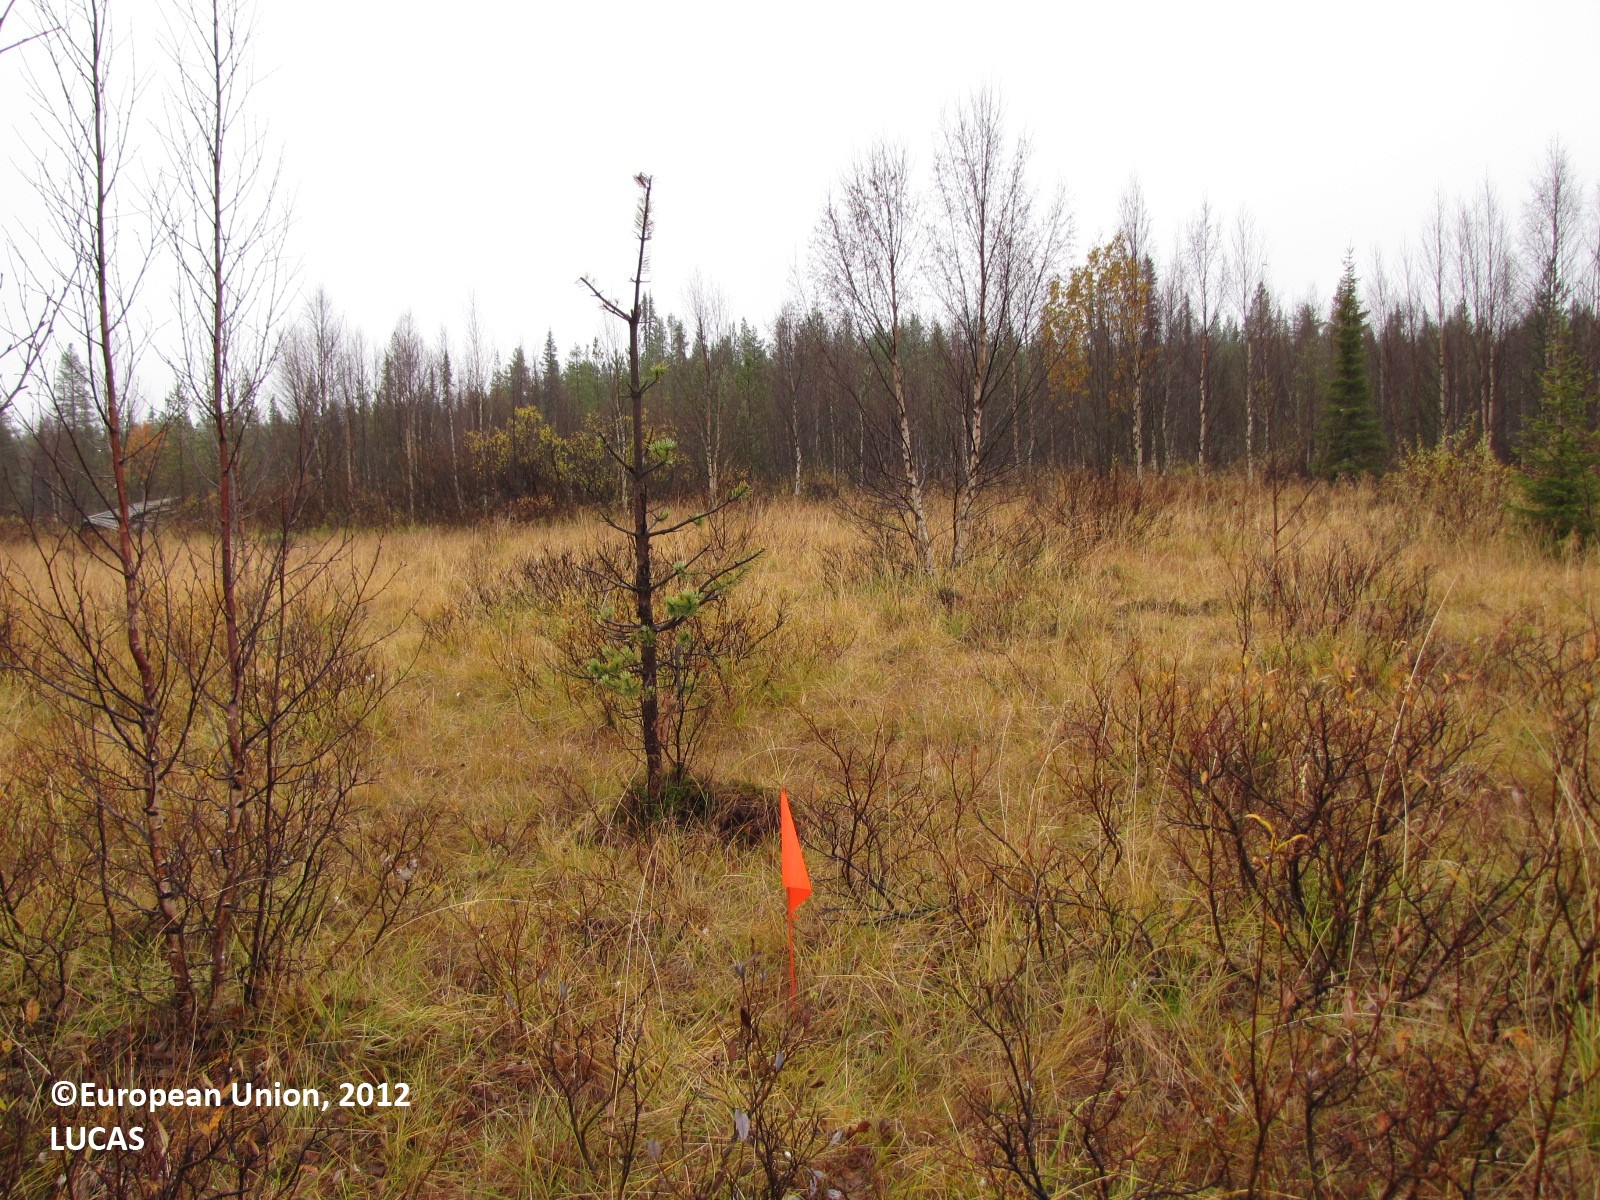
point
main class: Shrubland
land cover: Shrubland with sparse tree cover
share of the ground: 10 - 25 %
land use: Semi-natural and natural areas not in use
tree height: < 5 m
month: September
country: FI
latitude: 67.7501
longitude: 23.6220
